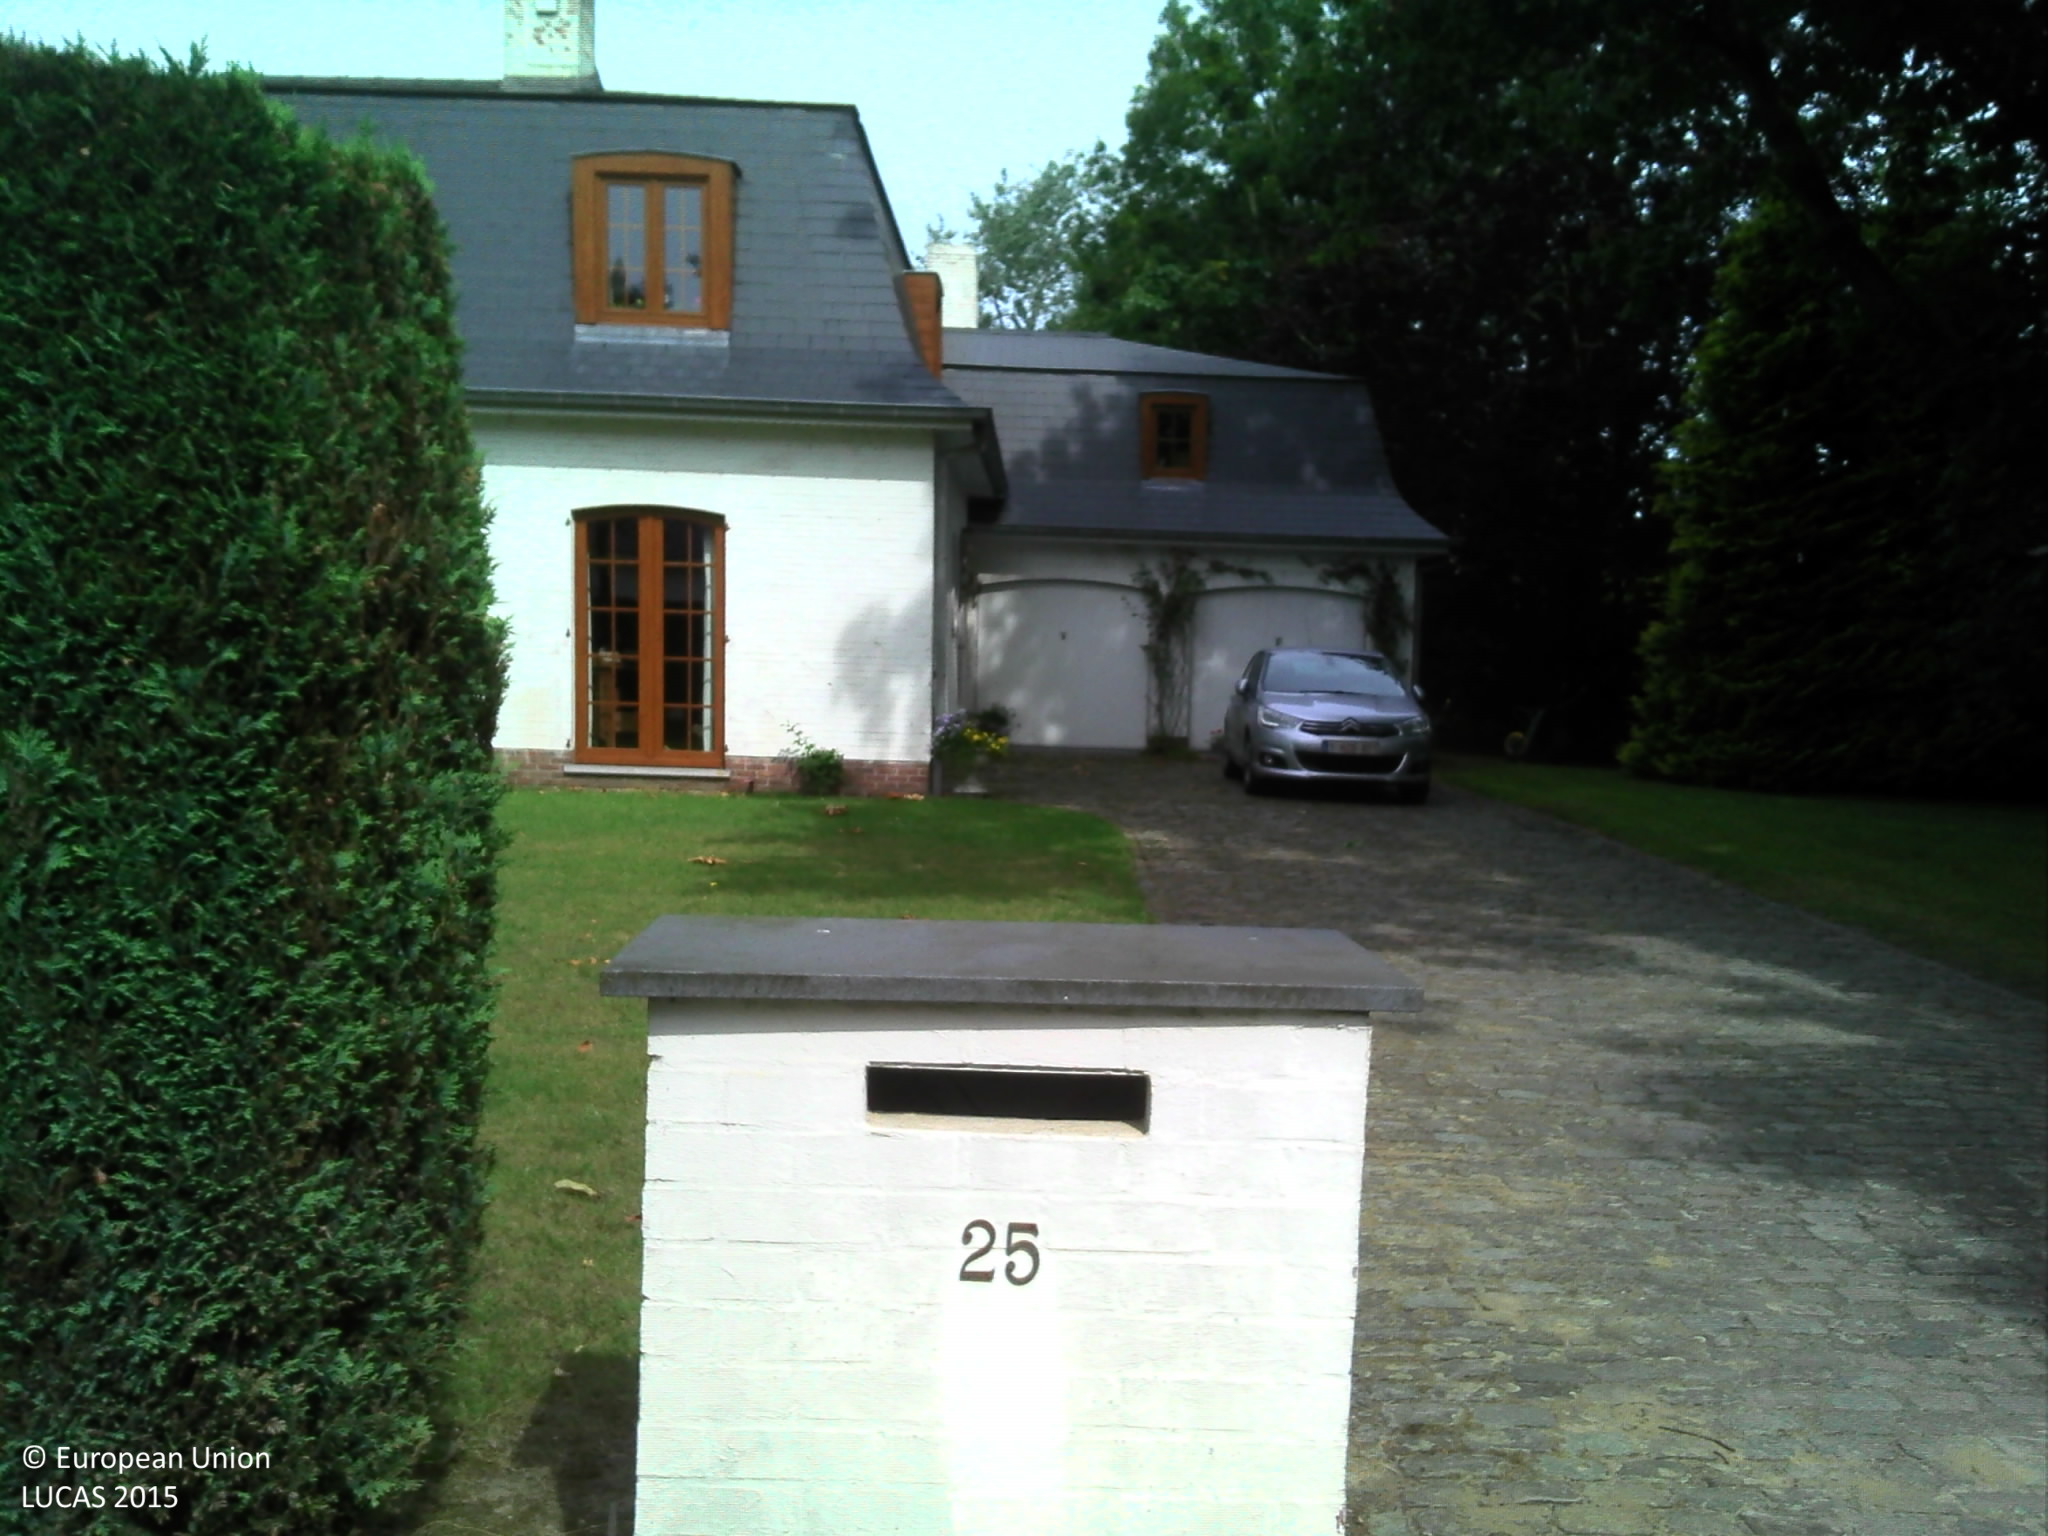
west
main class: Grassland
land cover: Grassland with sparse tree/shrub cover
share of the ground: > 75 %
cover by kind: herbaceous plants 95 %, broadleaved forest trees 5 %
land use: Residential
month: June
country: BE
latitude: 51.0009
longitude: 3.6802
